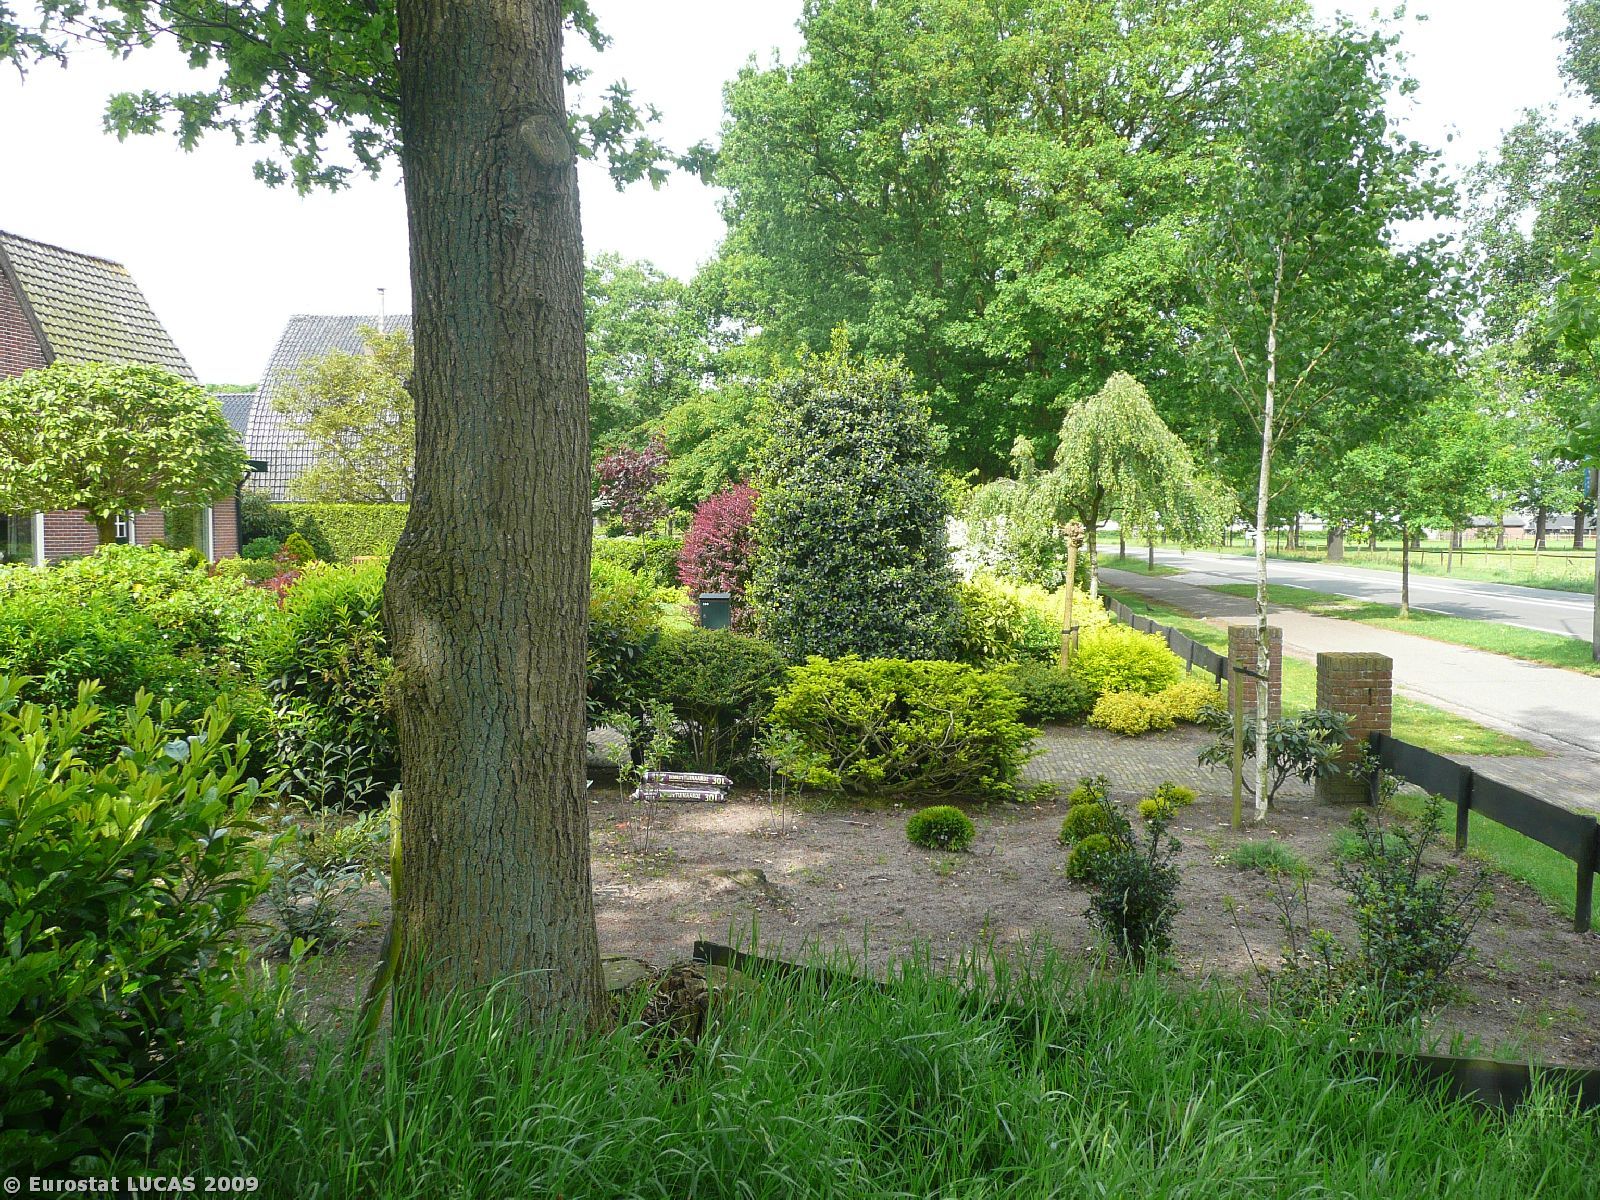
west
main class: Woodland
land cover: Coniferous woodland
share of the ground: > 75 %
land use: Residential
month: May
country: NL
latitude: 52.1598
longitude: 5.3349
